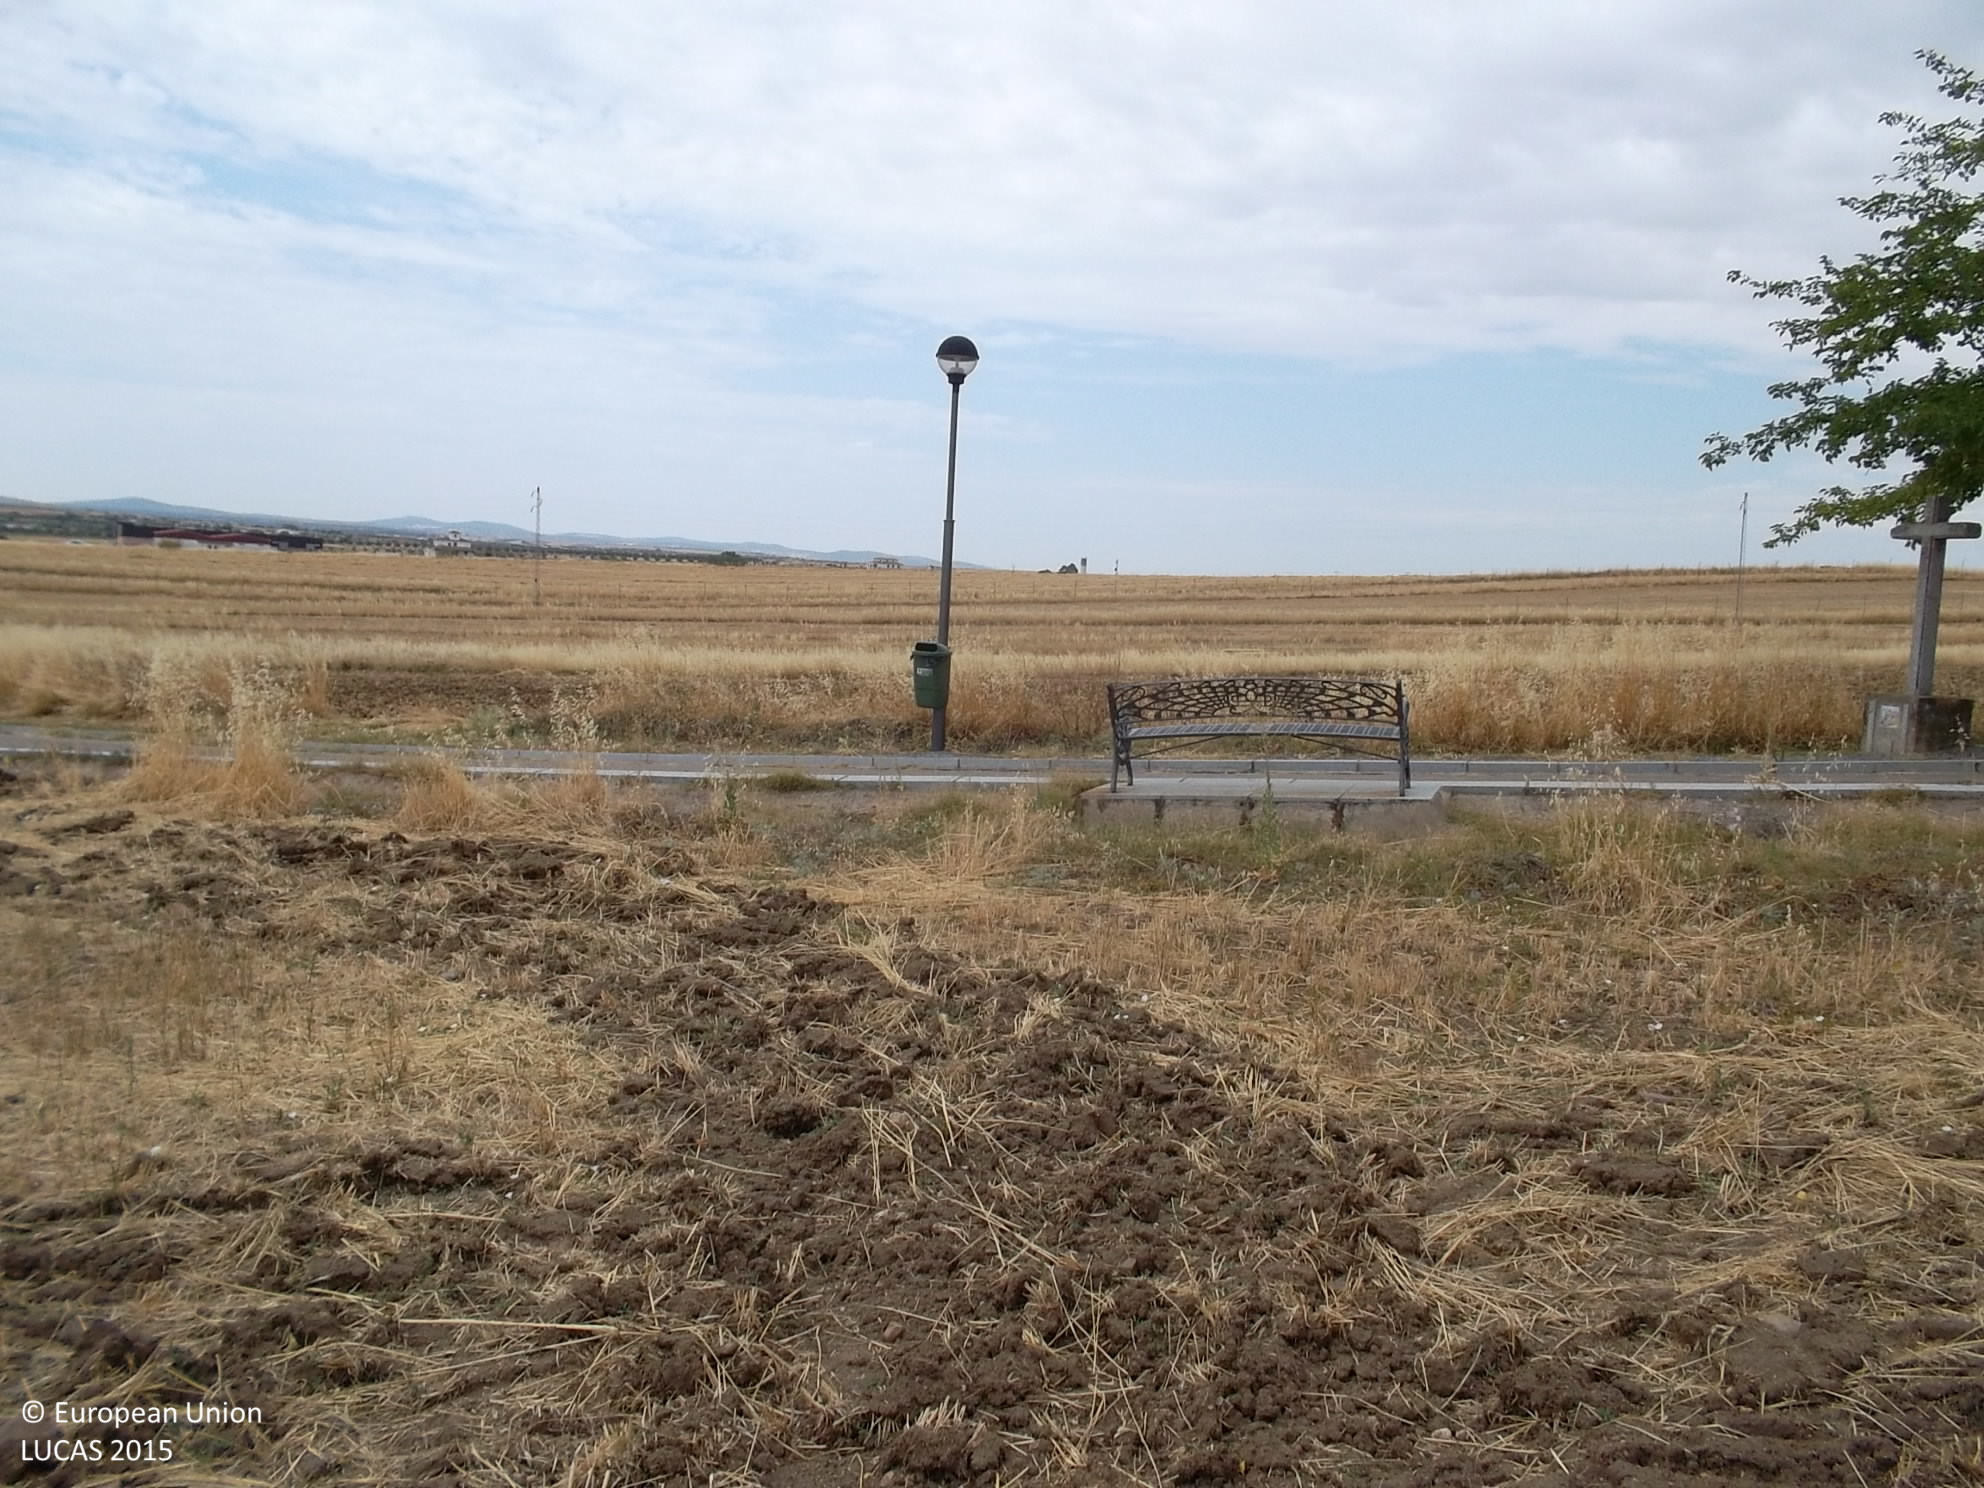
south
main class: Cropland
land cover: Common wheat
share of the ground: < 10 %
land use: Agriculture (excluding fallow land and kitchen gardens)
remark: Harvested field
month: July
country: ES
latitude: 38.5123
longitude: -5.1569
